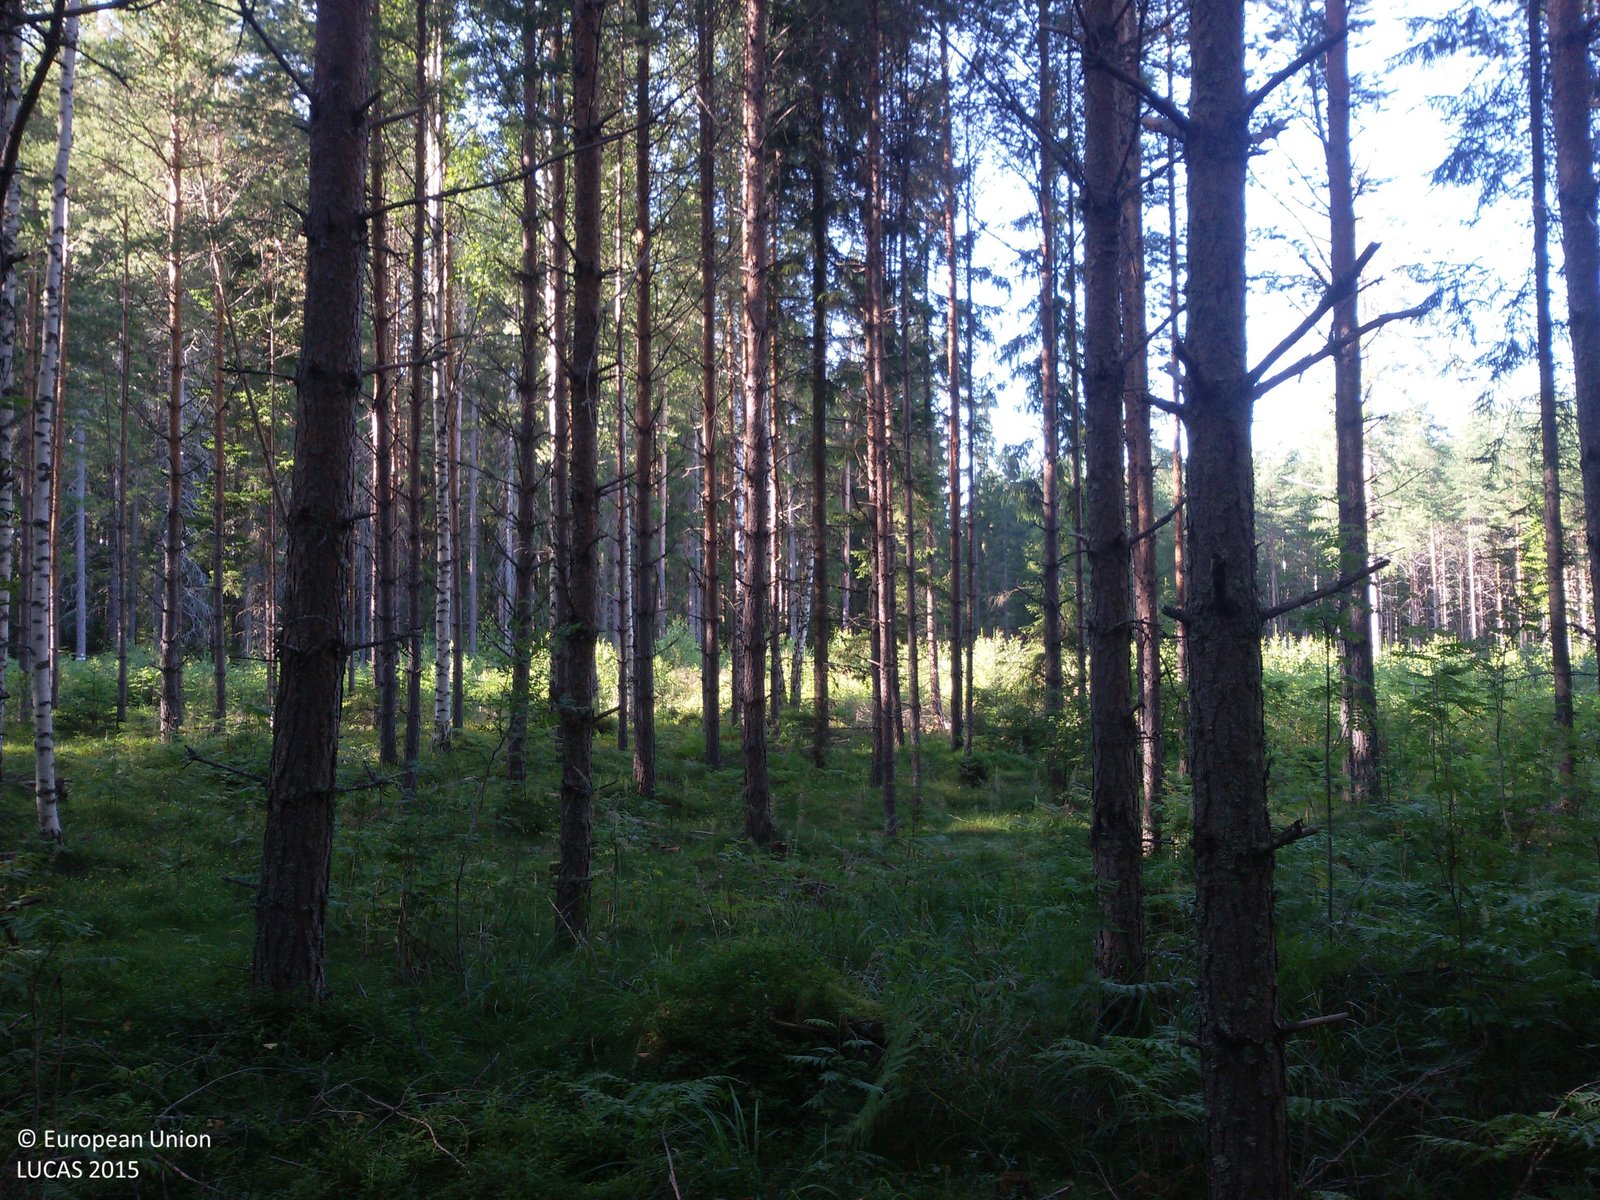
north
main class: Woodland
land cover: Pine dominated mixed woodland
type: boreal forest
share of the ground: > 75 %
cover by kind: coniferous forest trees 50 %, broadleaved forest trees 45 %, shrubs 5 %
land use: Forestry
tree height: > 5 m
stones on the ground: < 10 %
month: August
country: SE
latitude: 60.5762
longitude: 16.4298
